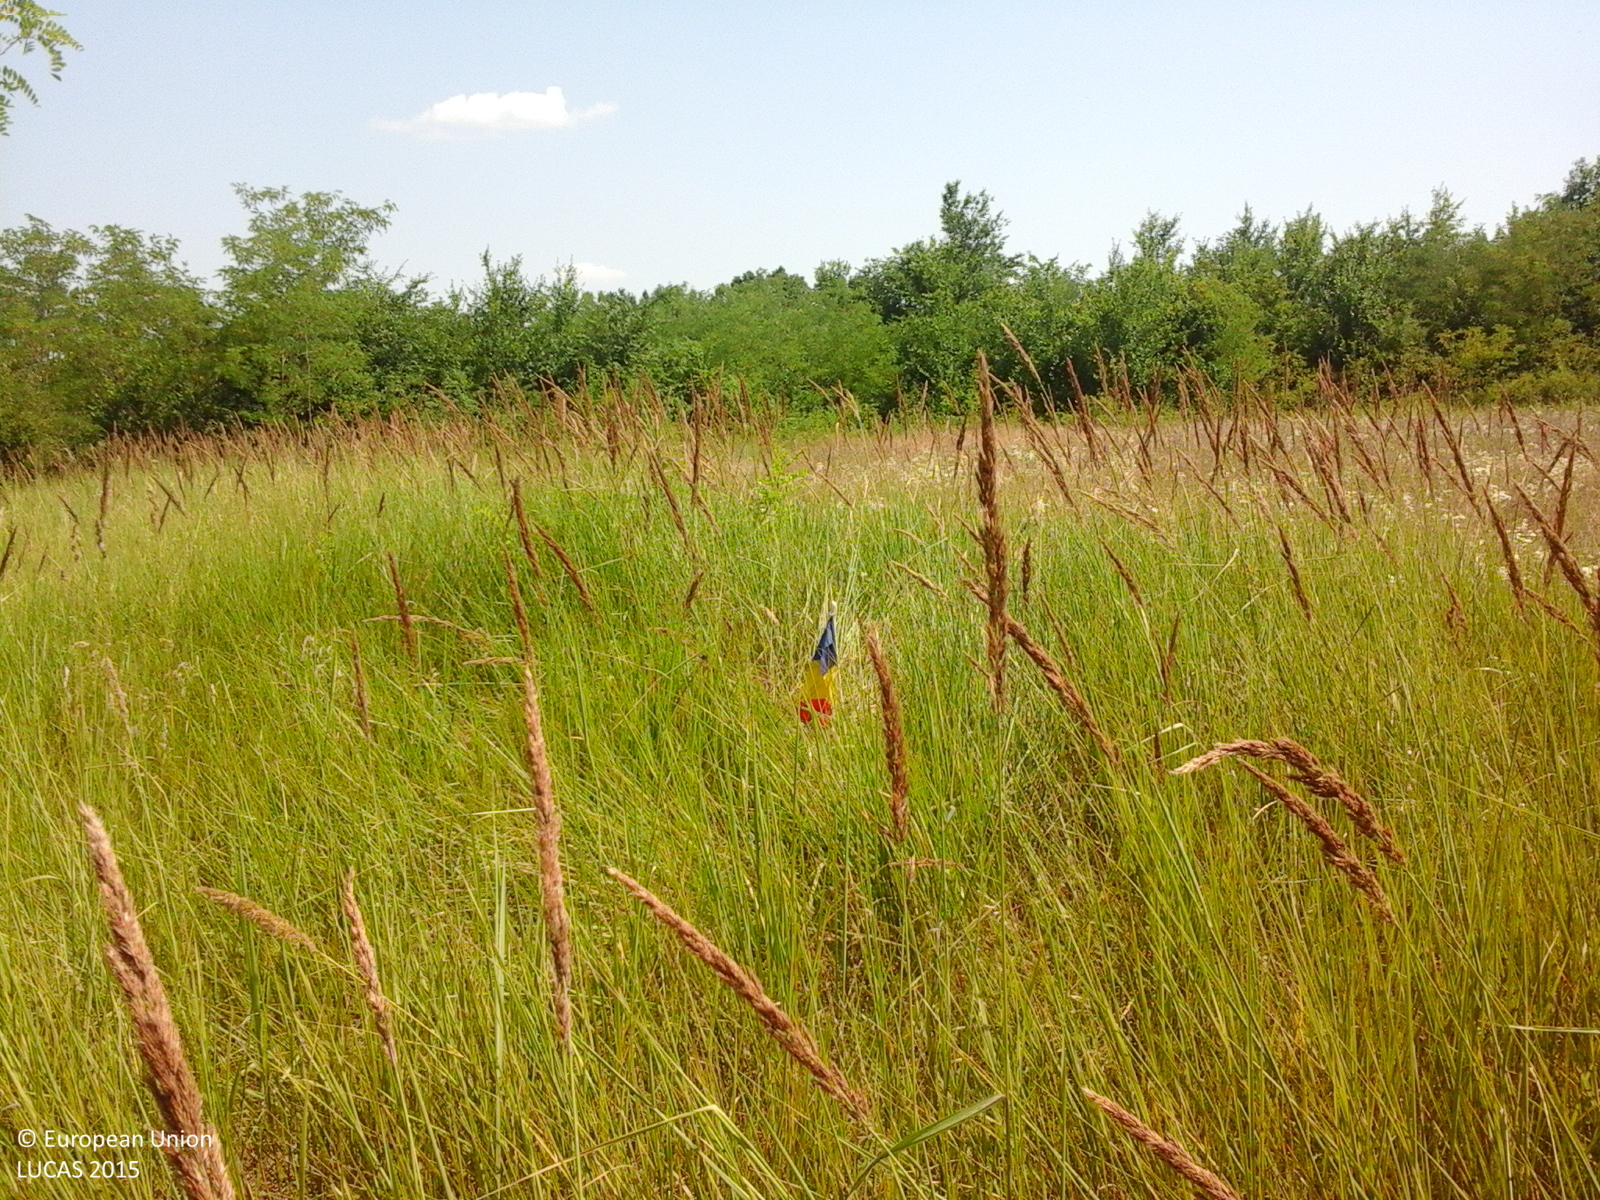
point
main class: Grassland
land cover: Spontaneously vegetated surfaces
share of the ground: > 75 %
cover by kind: herbaceous plants 100 %
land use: Fallow land
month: July
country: RO
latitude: 44.7375
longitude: 24.6106
